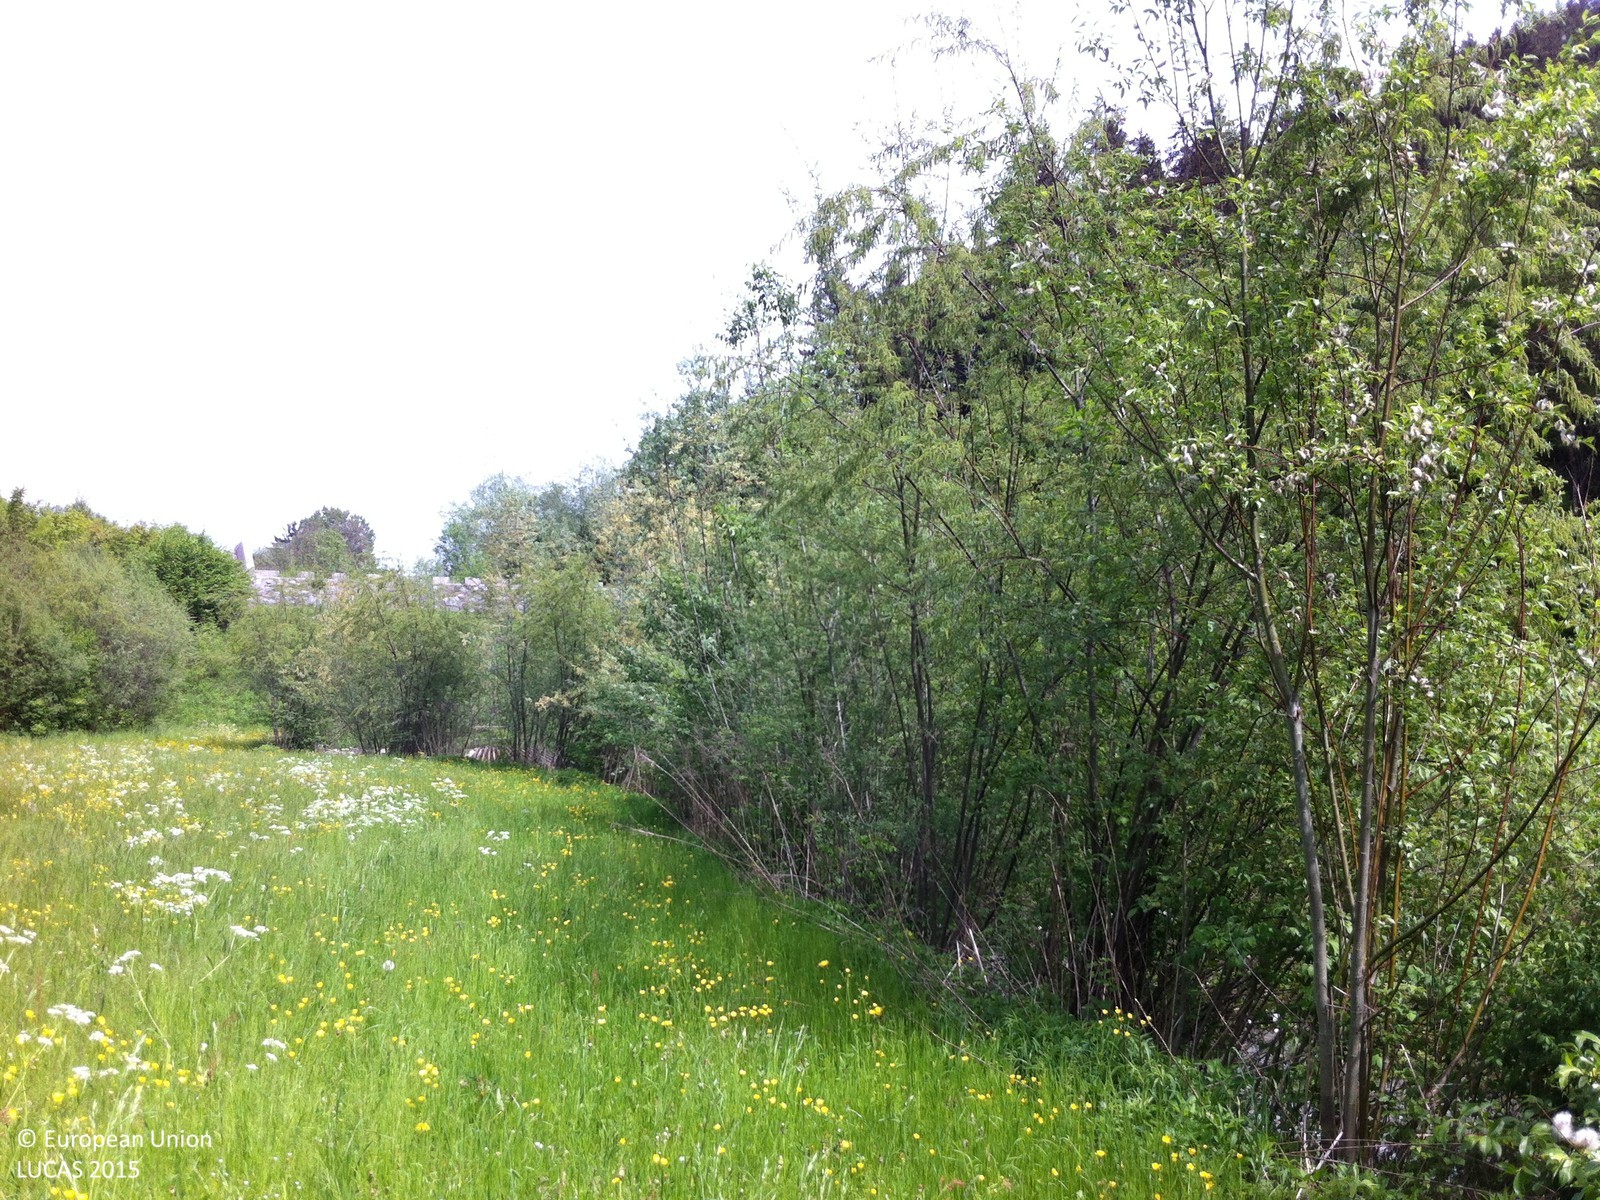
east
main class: Grassland
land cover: Grassland without tree/shrub cover
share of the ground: > 75 %
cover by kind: herbaceous plants 100 %
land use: Agriculture (excluding fallow land and kitchen gardens)
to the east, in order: Grassland without tree/shrub cover; Abandoned hedges; Inland fresh running water; Sand; Grassland without tree/shrub cover; Shrubland without tree cover; Tracks; Broadleaved woodland; Grassland without tree/shrub cover; Tracks; Broadleaved woodland; Tracks; Spruce dominated coniferous woodland; Grassland without tree/shrub cover
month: May
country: AT
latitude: 47.2437
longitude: 11.3067
